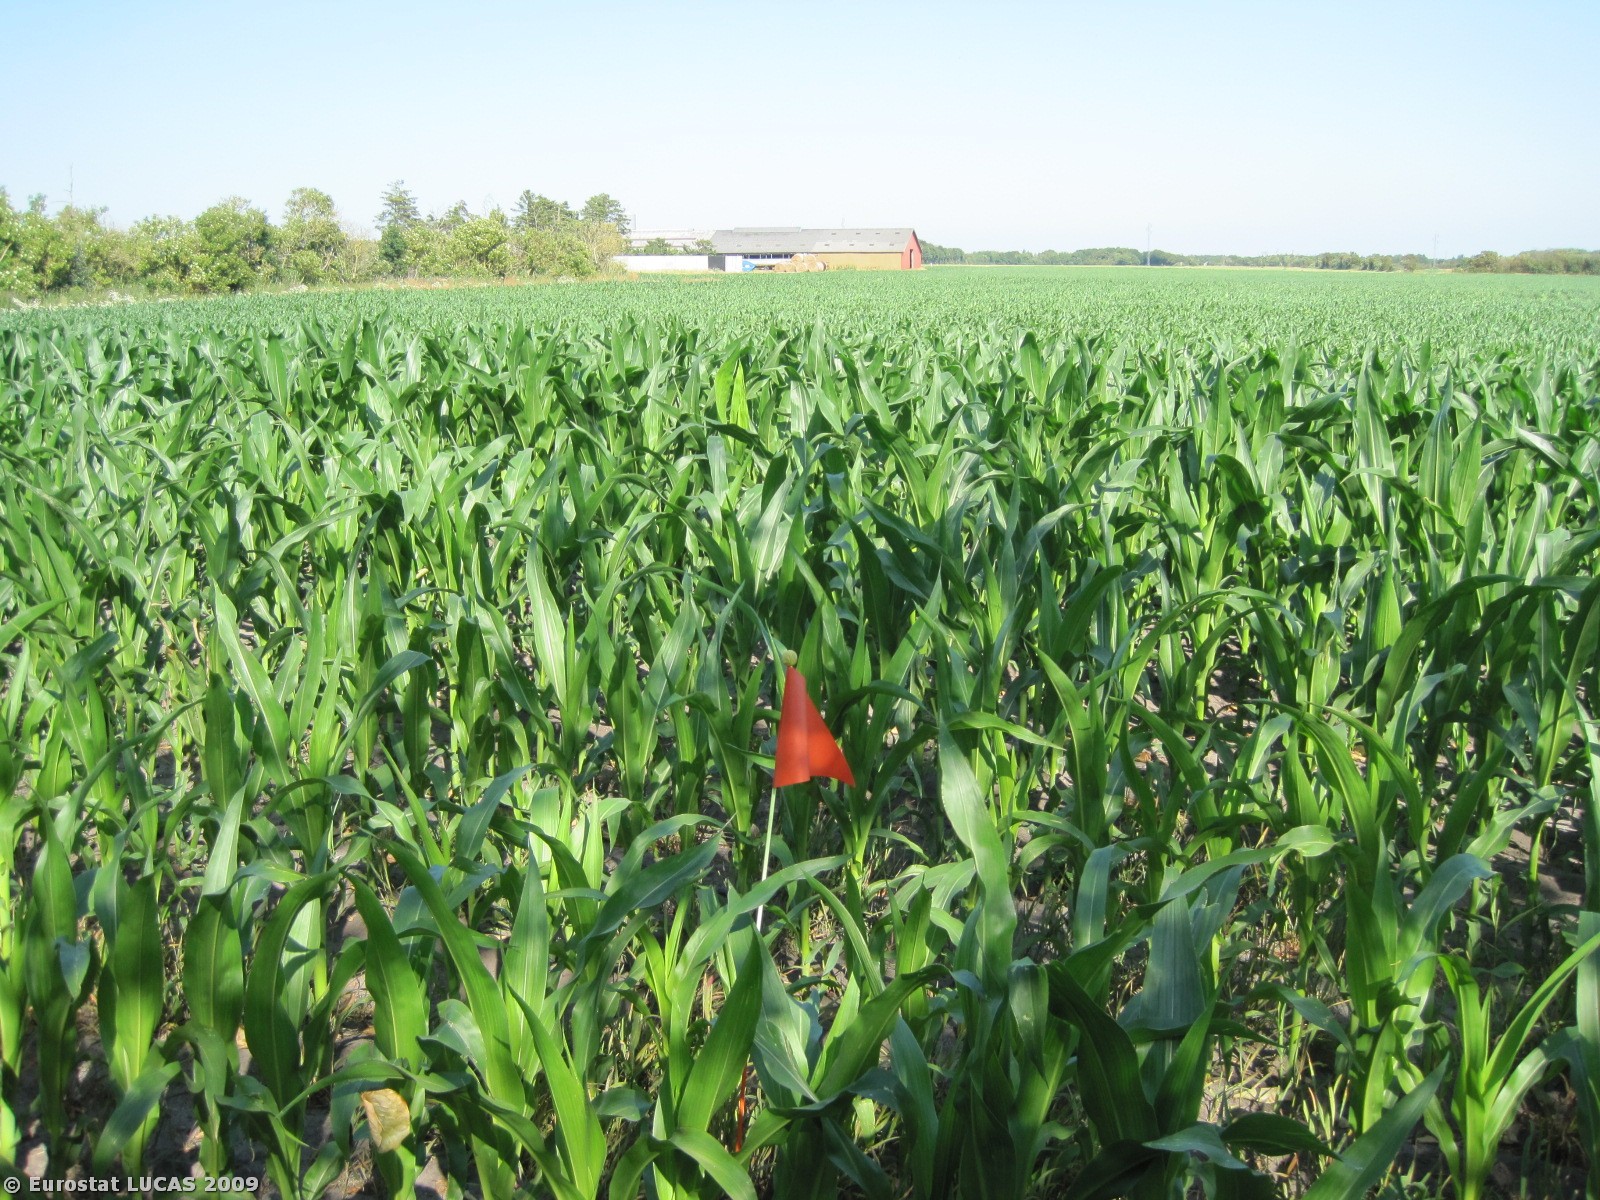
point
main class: Woodland
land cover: Broadleaved woodland
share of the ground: 25 - 50 %
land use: Forestry
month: July
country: DK
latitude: 56.3767
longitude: 8.4959
